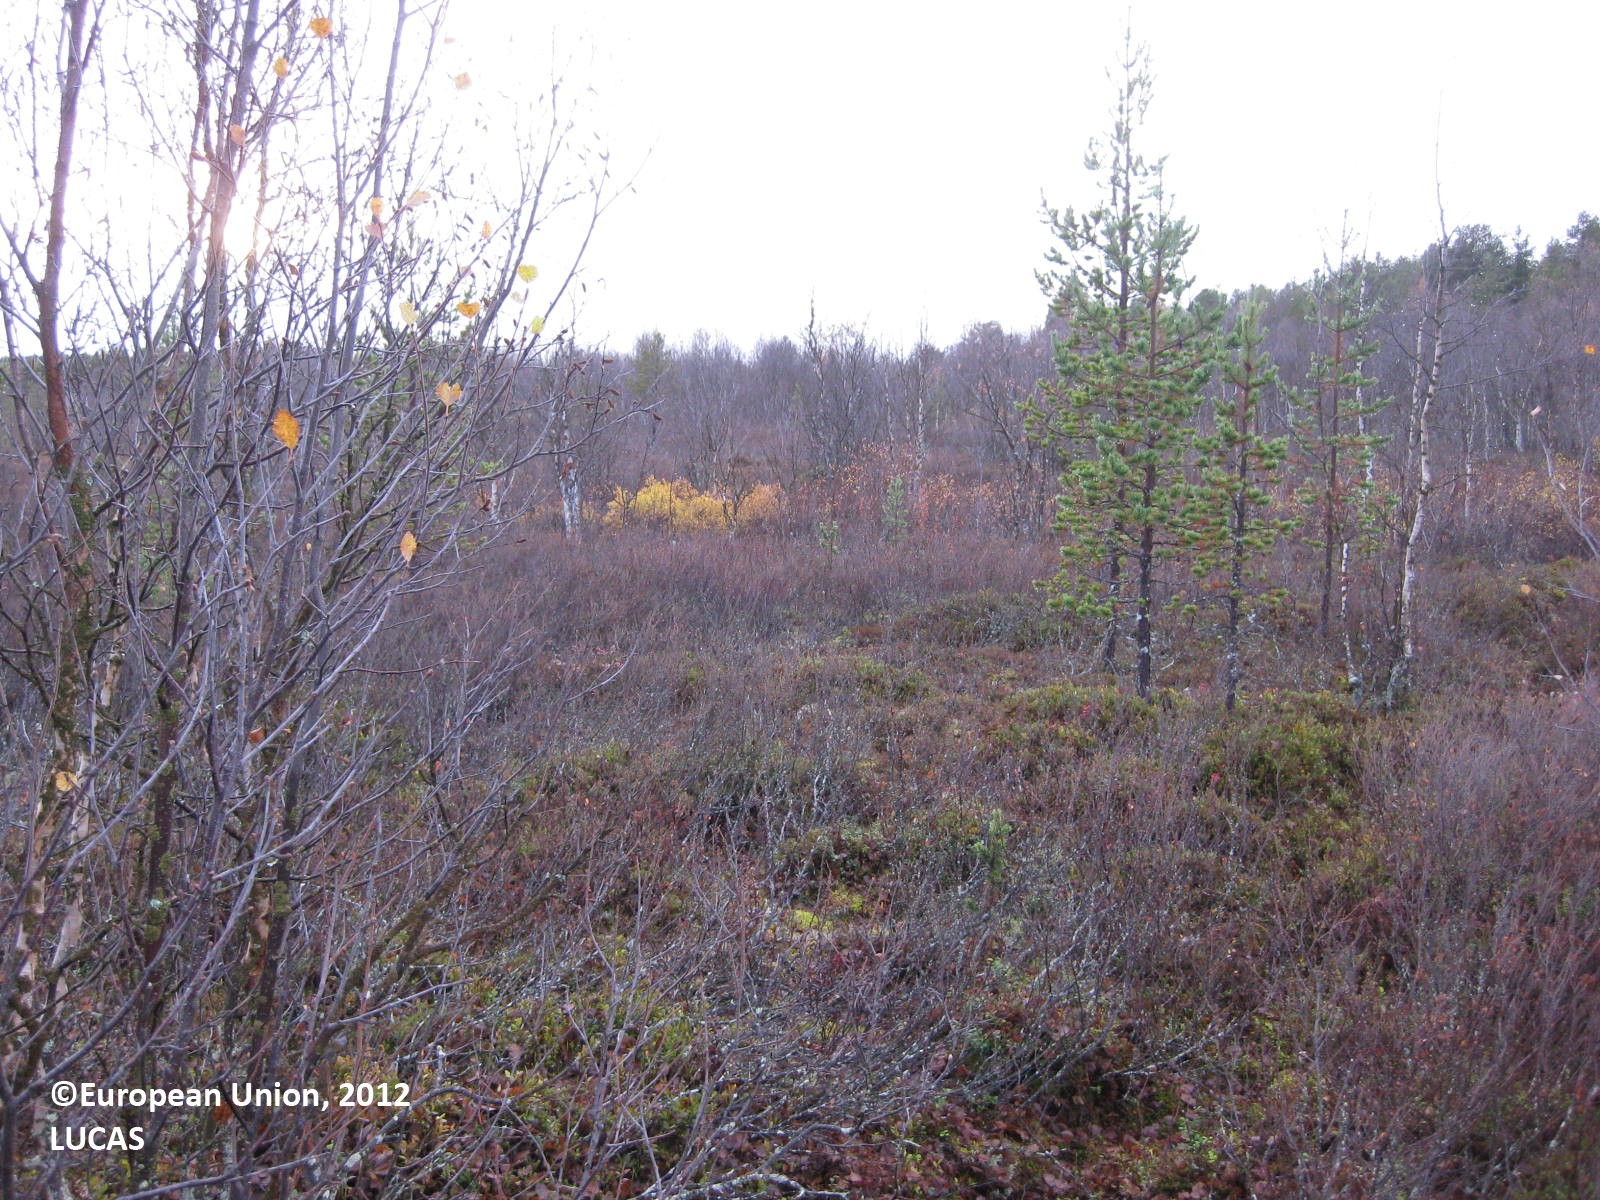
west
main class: Woodland
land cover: Broadleaved woodland
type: boreal forest
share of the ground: 25 - 50 %
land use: Agriculture (excluding fallow land and kitchen gardens)
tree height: > 5 m
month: September
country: FI
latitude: 68.4397
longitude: 24.0308
